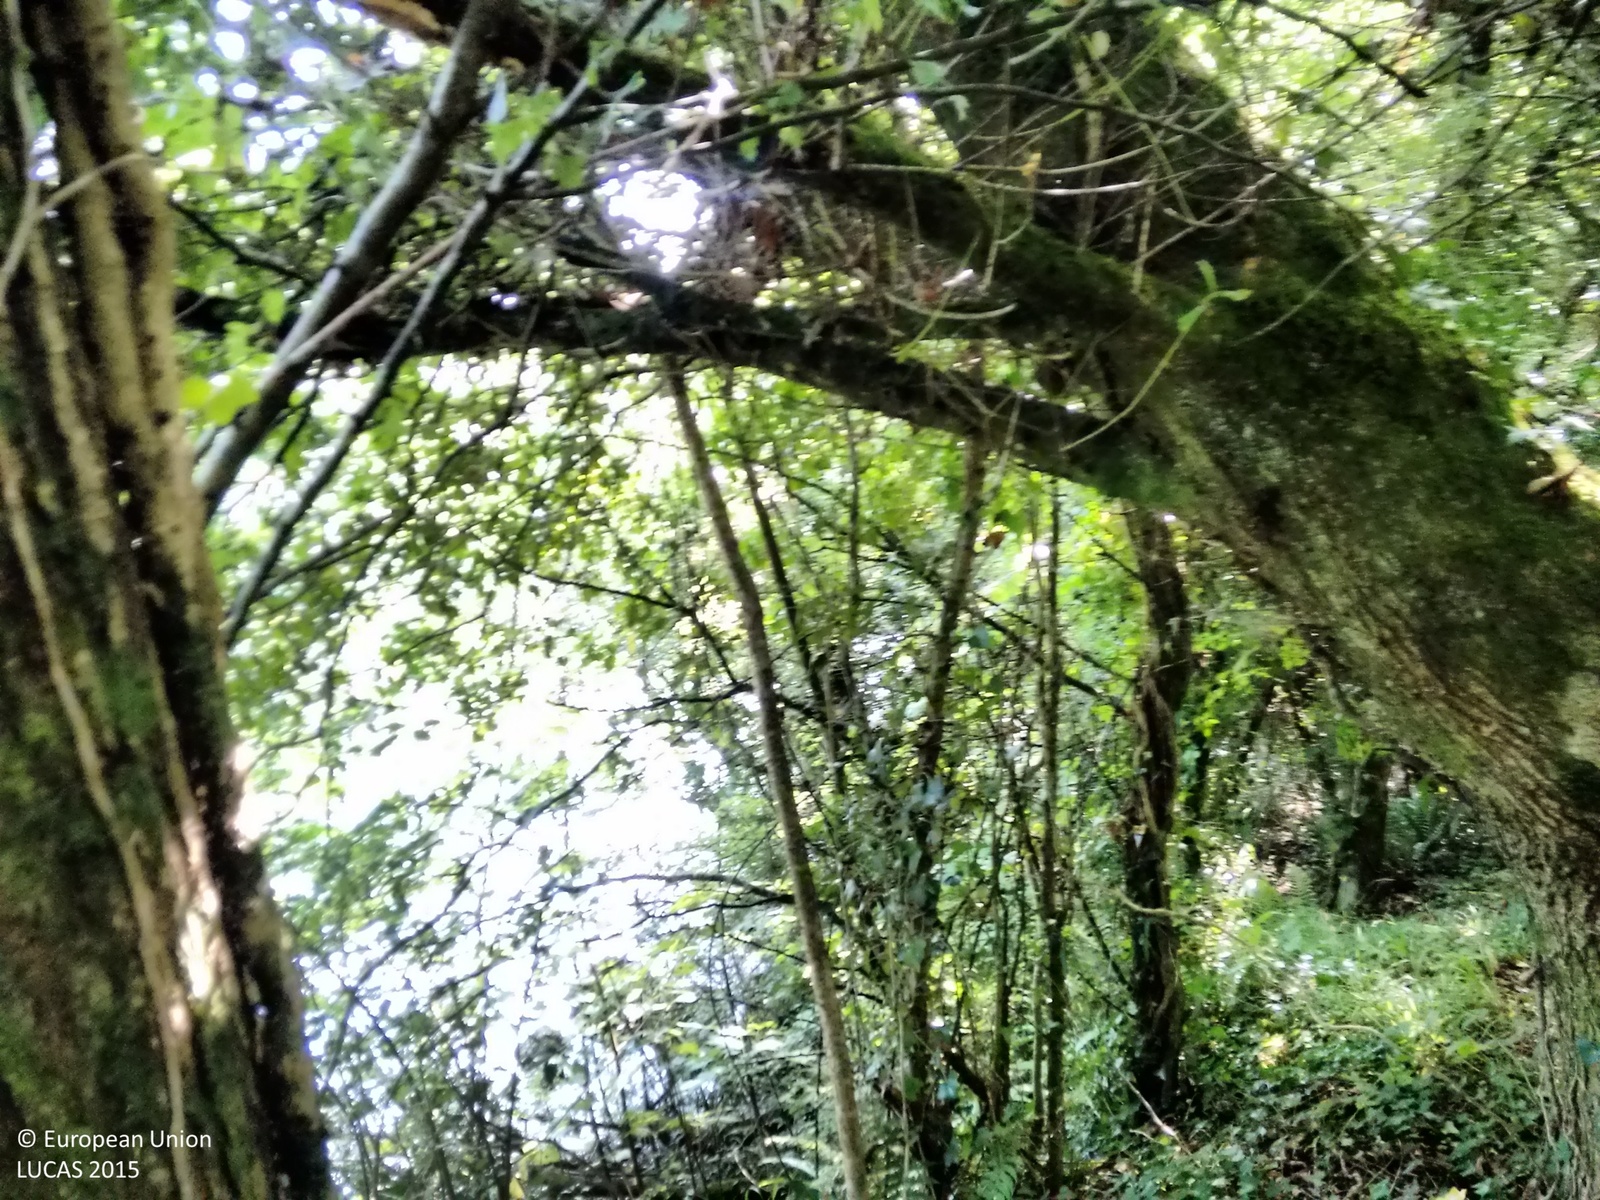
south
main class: Woodland
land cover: Broadleaved woodland
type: acidophilous oak and oak-birch forest
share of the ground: > 75 %
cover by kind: broadleaved forest trees 95 %, herbaceous plants 5 %
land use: Semi-natural and natural areas not in use
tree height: > 5 m
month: September
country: IE
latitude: 52.6960
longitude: -8.6204
